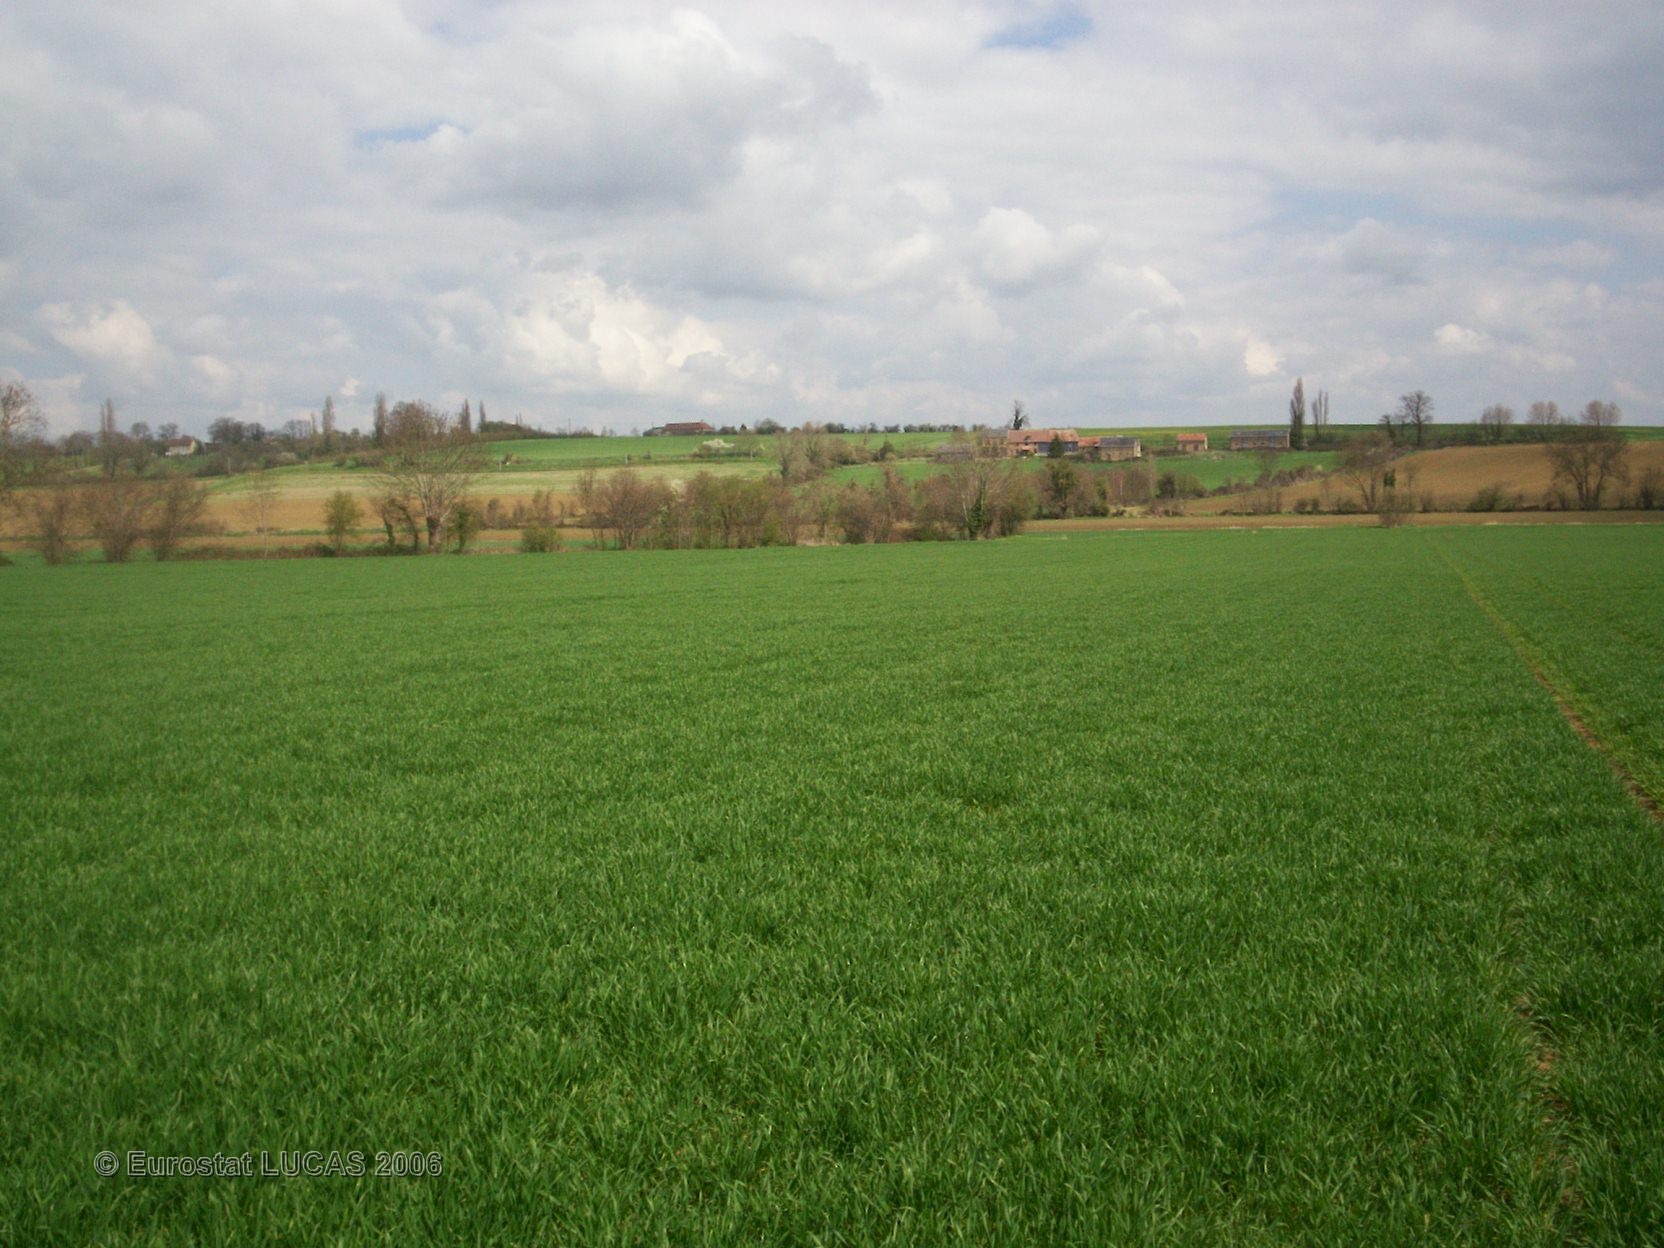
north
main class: Cropland
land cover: Common wheat
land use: Agriculture (excluding fallow land and kitchen gardens)
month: April
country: FR
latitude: 49.0187
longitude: 0.0009
